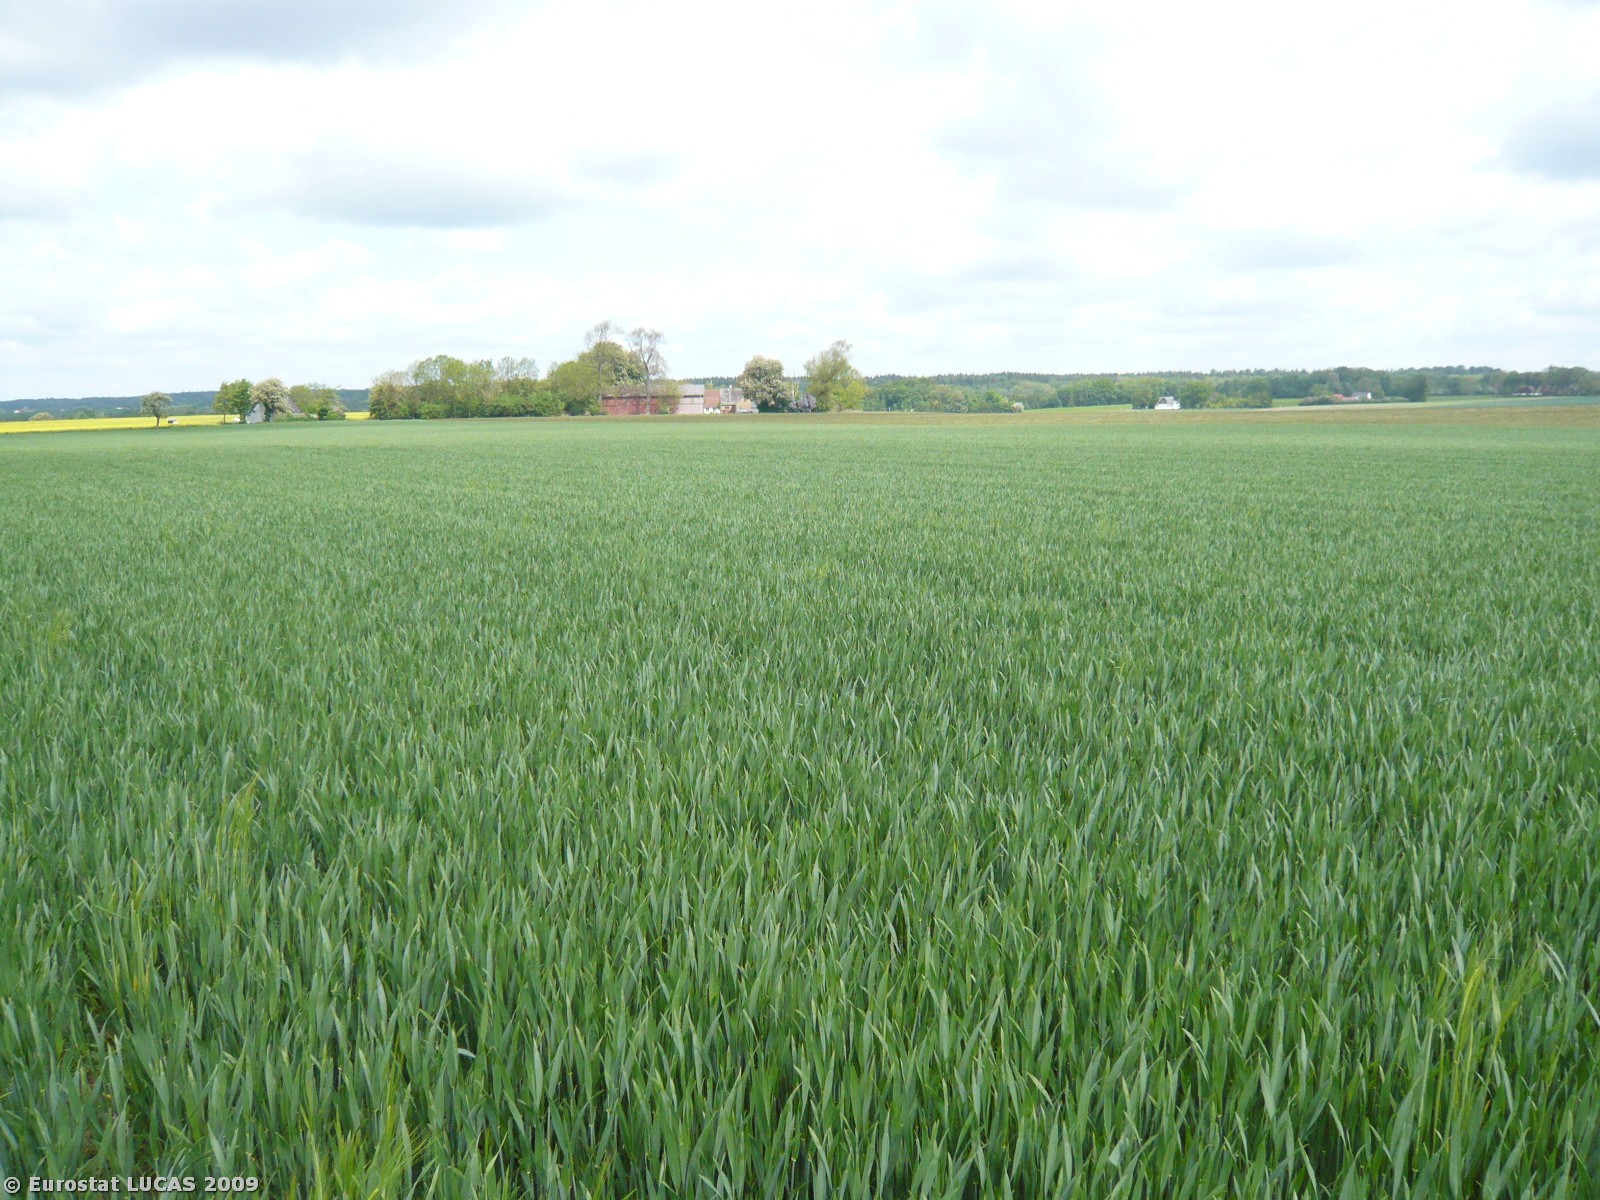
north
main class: Cropland
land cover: Common wheat
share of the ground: > 75 %
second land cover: Barley
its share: < 10 %
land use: Agriculture (excluding fallow land and kitchen gardens)
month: May
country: DK
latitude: 55.4741
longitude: 11.7862
